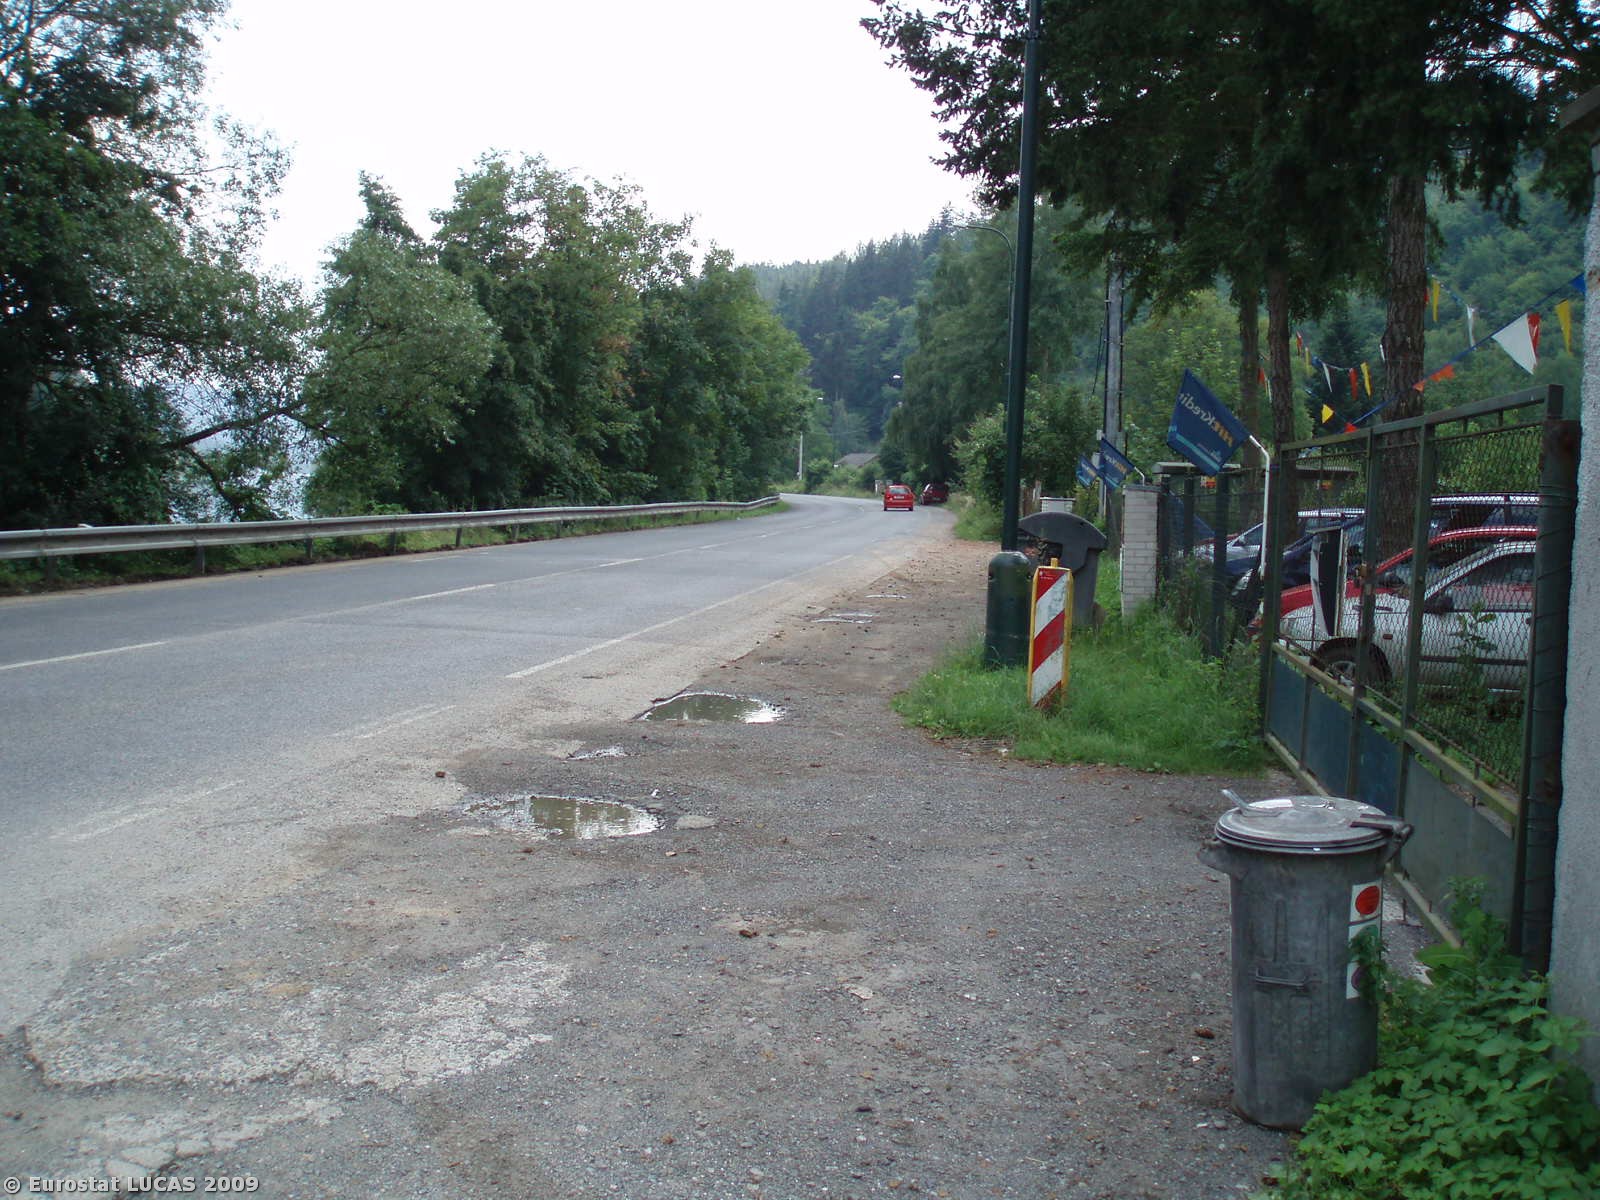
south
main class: Woodland
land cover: Broadleaved woodland
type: mesophytic deciduous forest
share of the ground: > 75 %
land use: Unused
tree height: > 5 m
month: July
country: CZ
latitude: 49.8838
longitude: 14.3854
